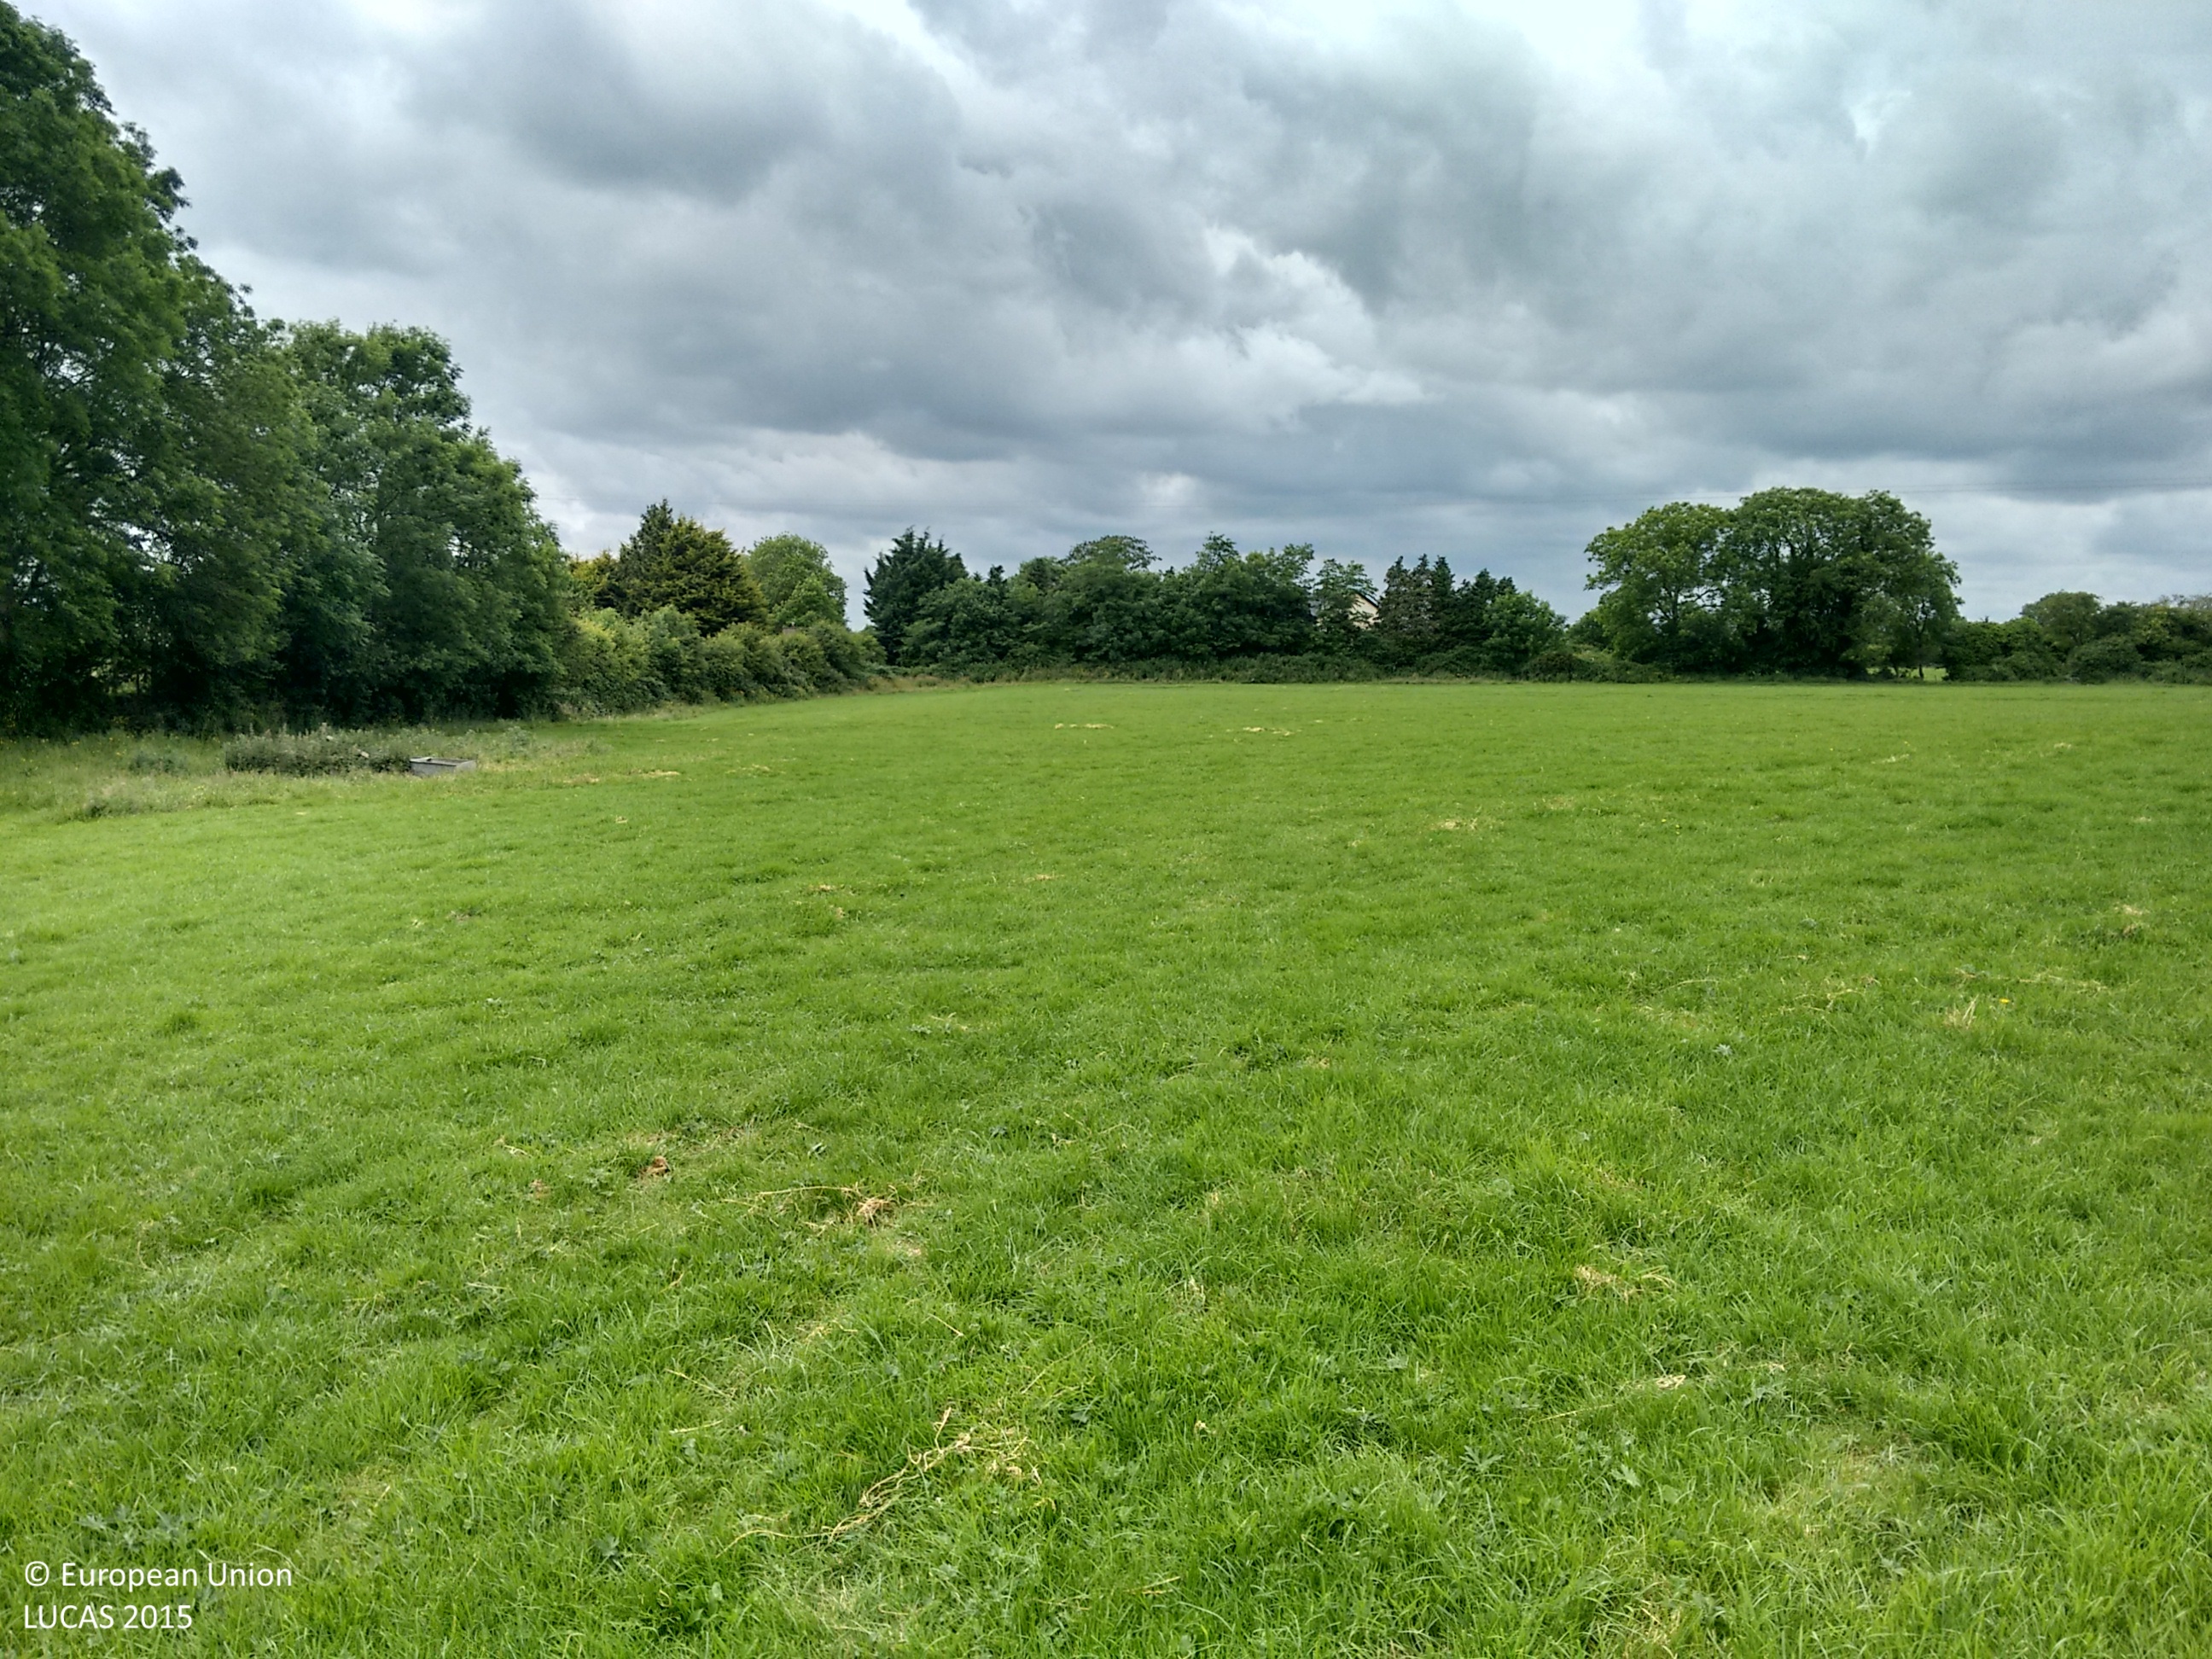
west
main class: Grassland
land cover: Grassland without tree/shrub cover
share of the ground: > 75 %
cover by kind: herbaceous plants 100 %
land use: Agriculture (excluding fallow land and kitchen gardens)
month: June
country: IE
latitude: 53.6424
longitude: -6.7266
